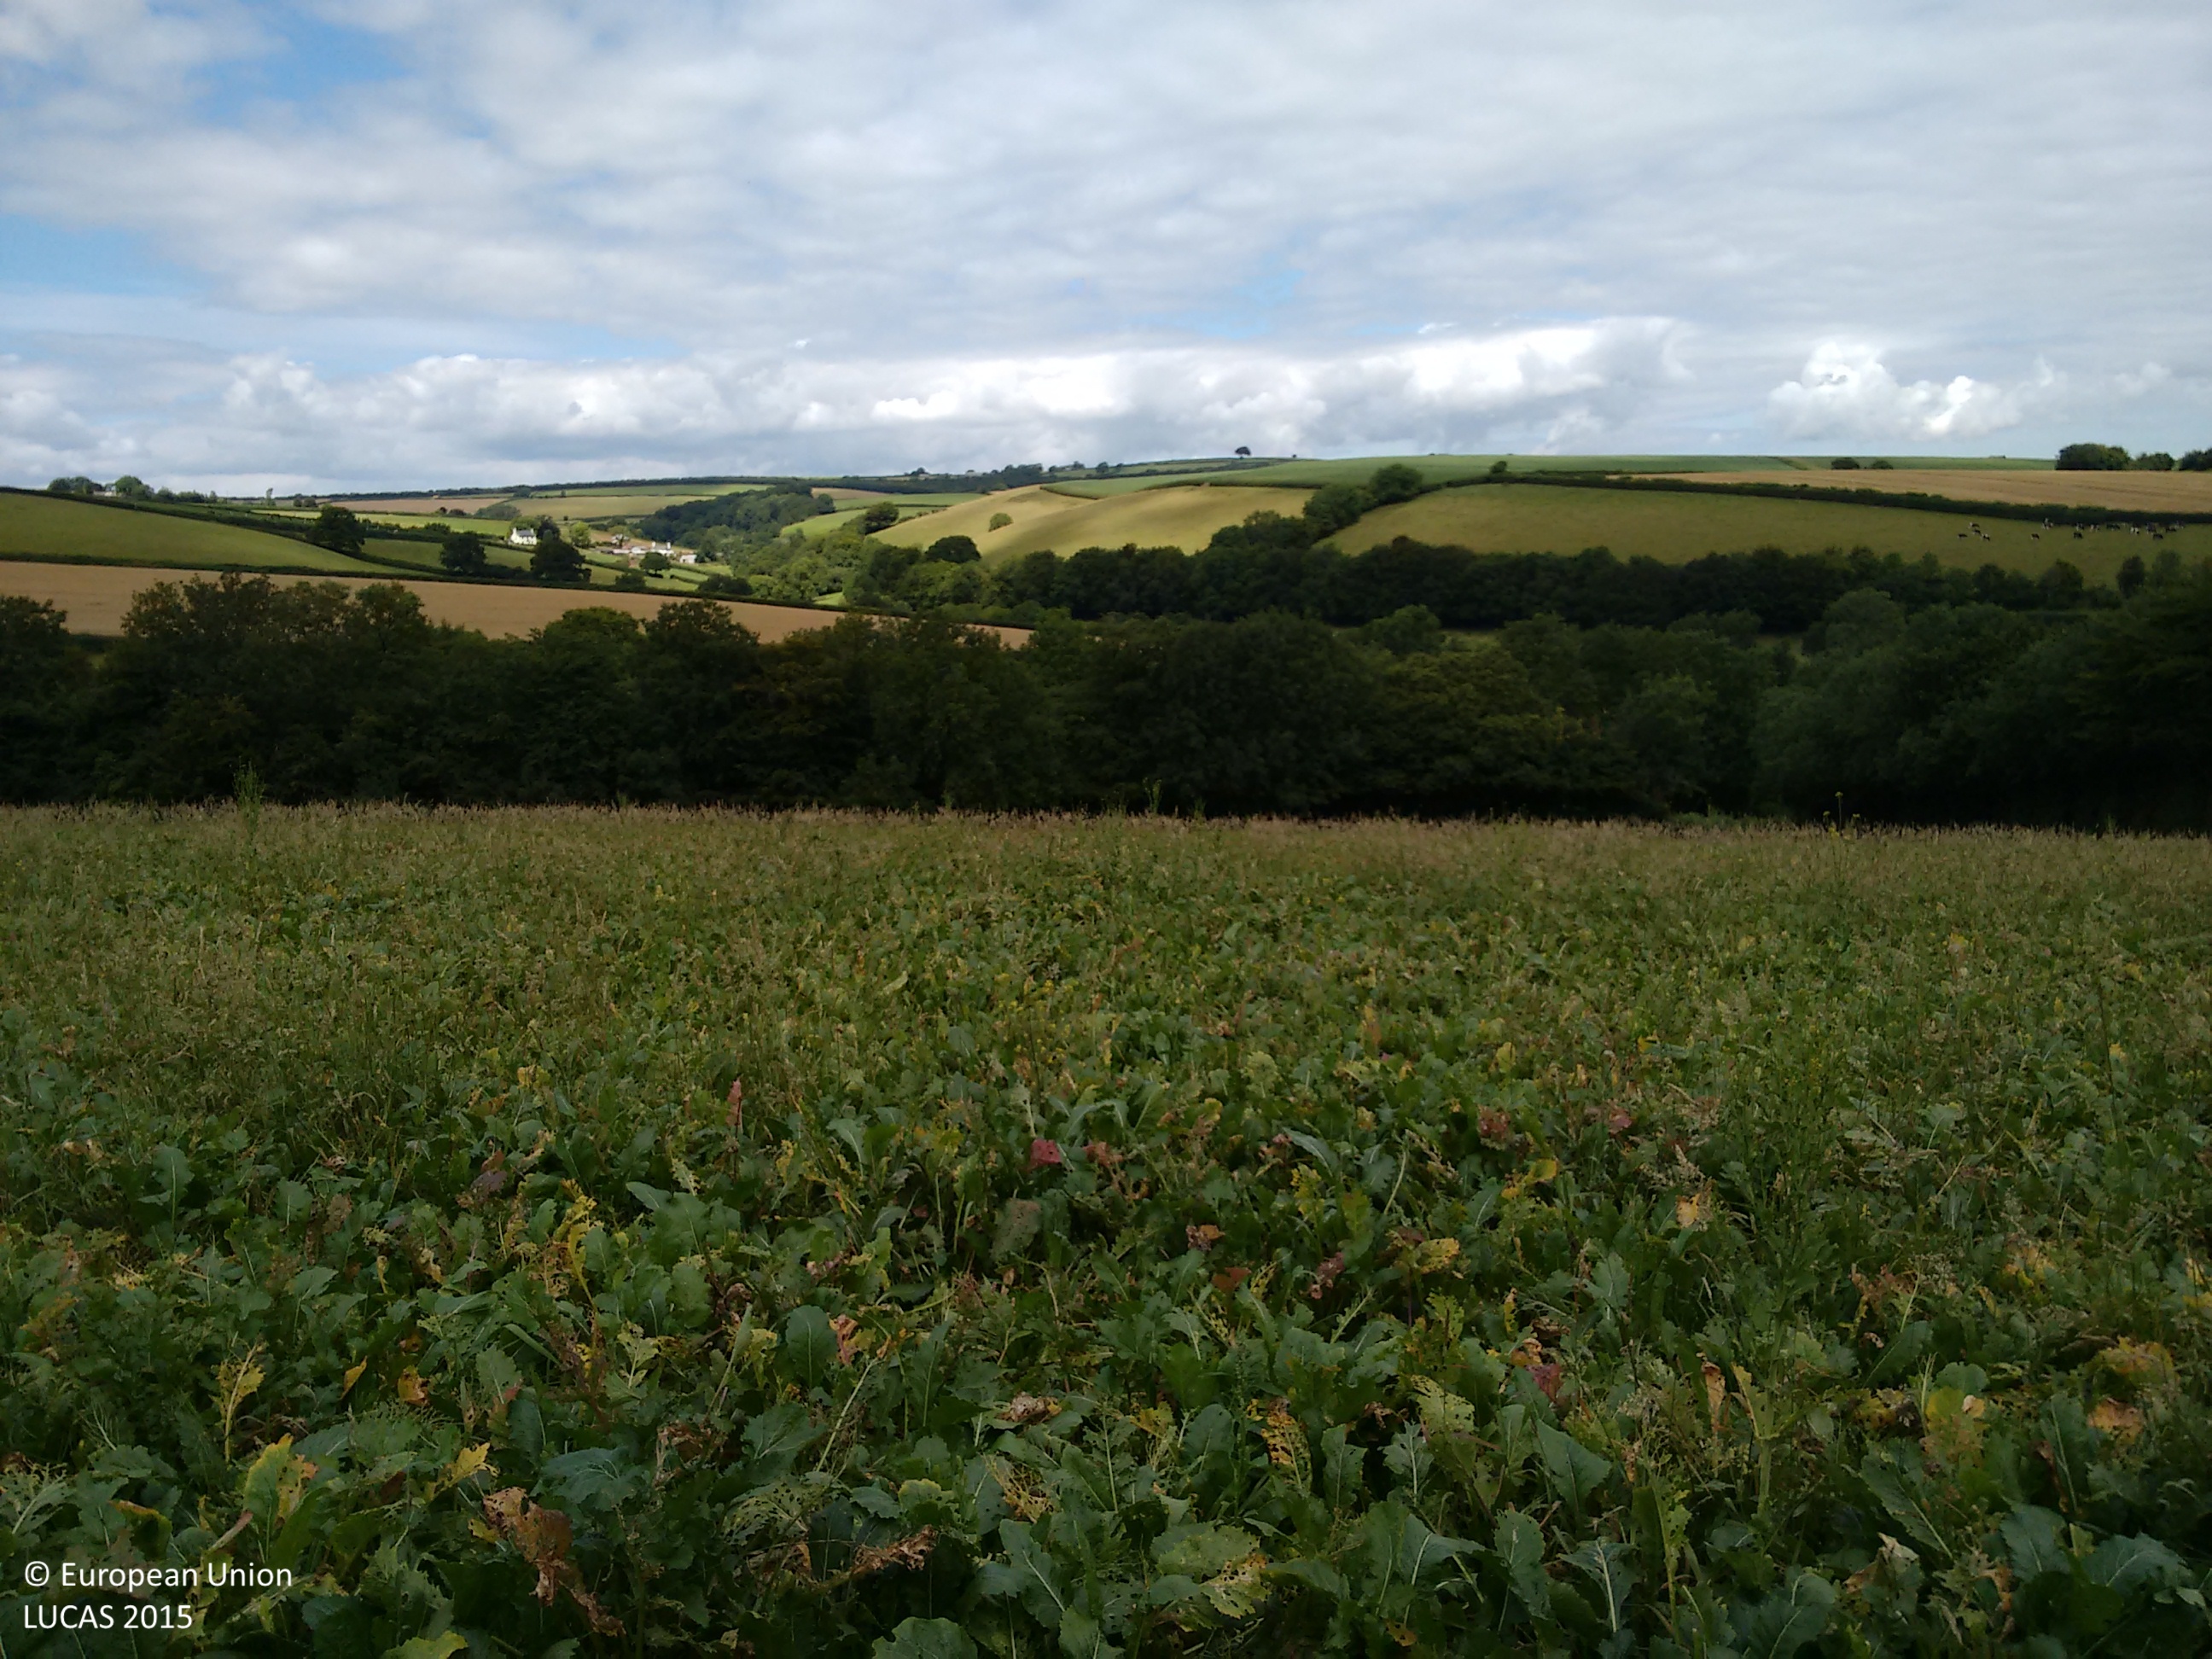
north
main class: Cropland
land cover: Other leguminous and mixtures for fodder
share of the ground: > 75 %
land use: Agriculture (excluding fallow land and kitchen gardens)
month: August
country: GB
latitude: 50.9201
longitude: -3.5565
